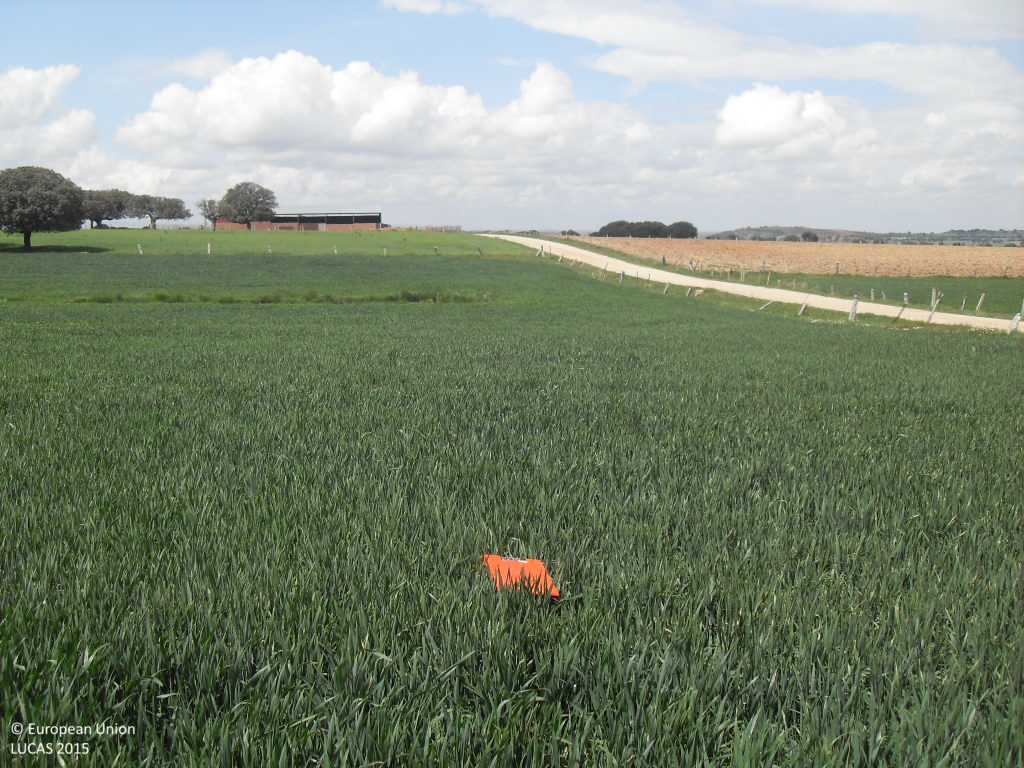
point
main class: Cropland
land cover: Common wheat
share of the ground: > 75 %
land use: Agriculture (excluding fallow land and kitchen gardens)
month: April
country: ES
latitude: 40.7478
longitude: -5.3100
